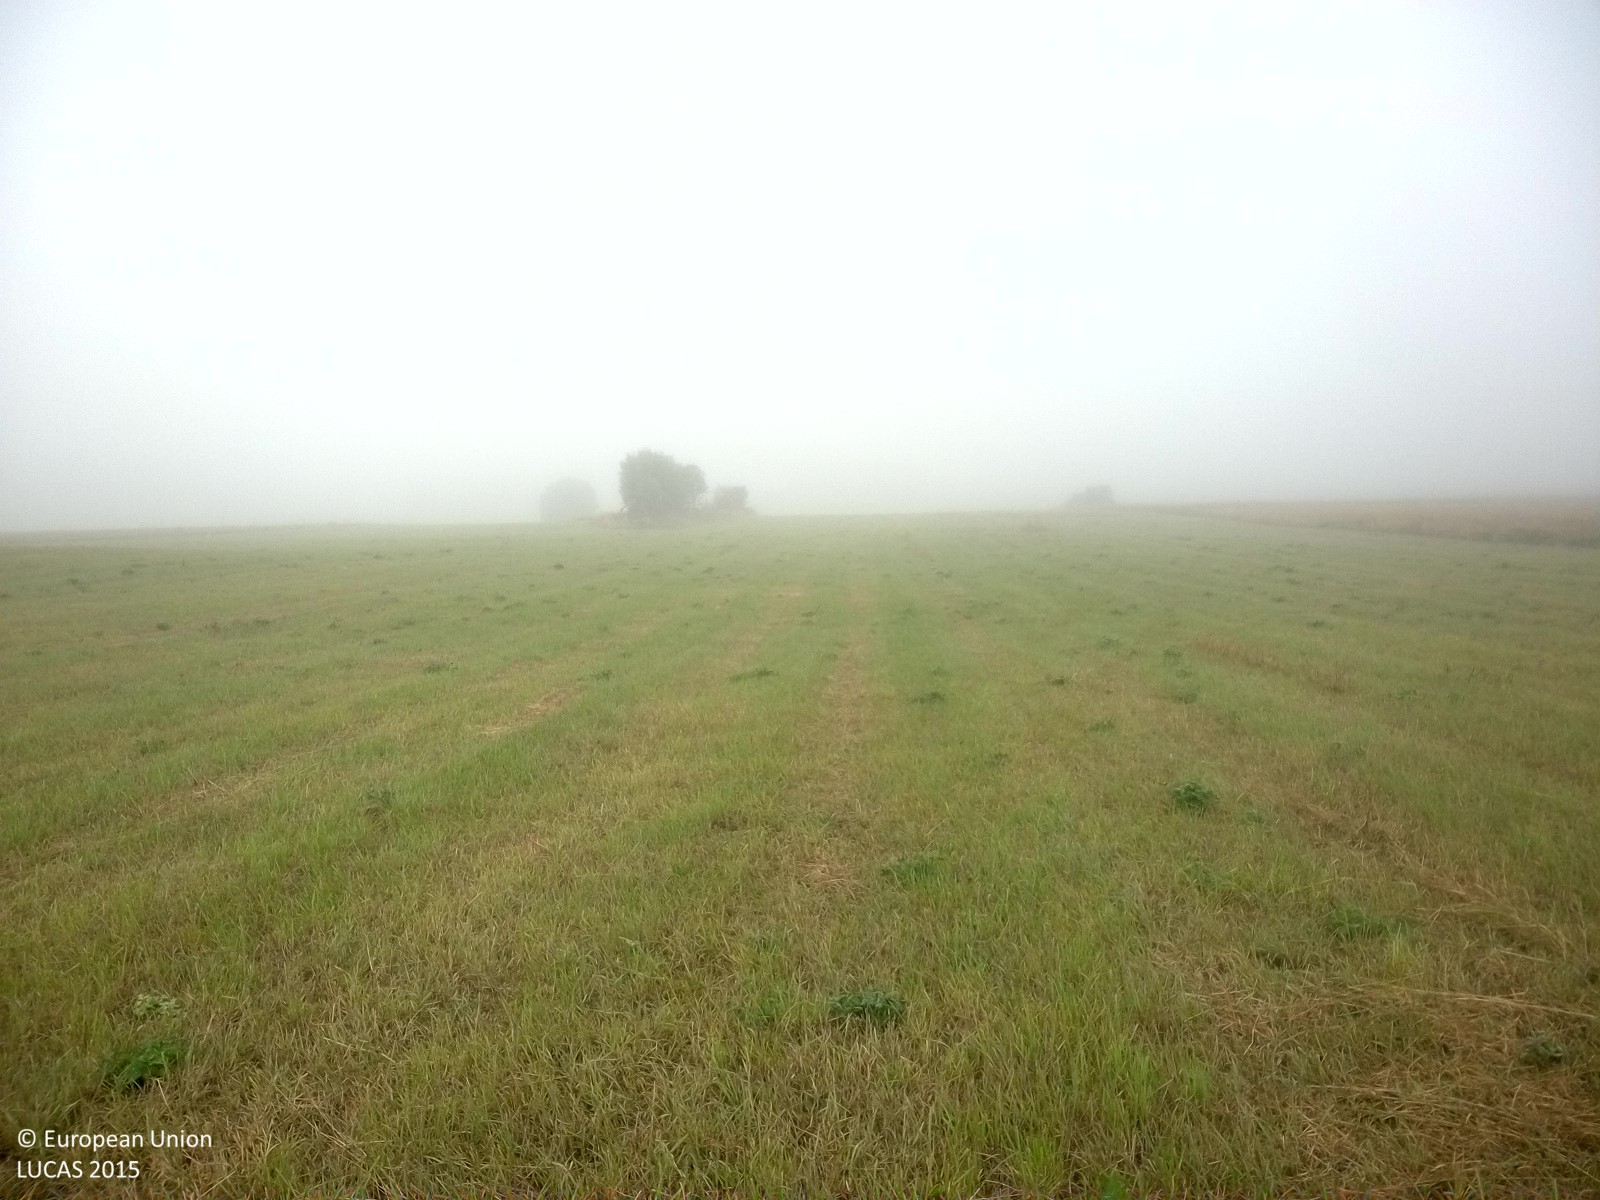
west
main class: Grassland
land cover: Grassland without tree/shrub cover
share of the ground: > 75 %
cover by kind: herbaceous plants 100 %
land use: Agriculture (excluding fallow land and kitchen gardens)
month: August
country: SE
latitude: 59.3447
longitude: 15.2137
